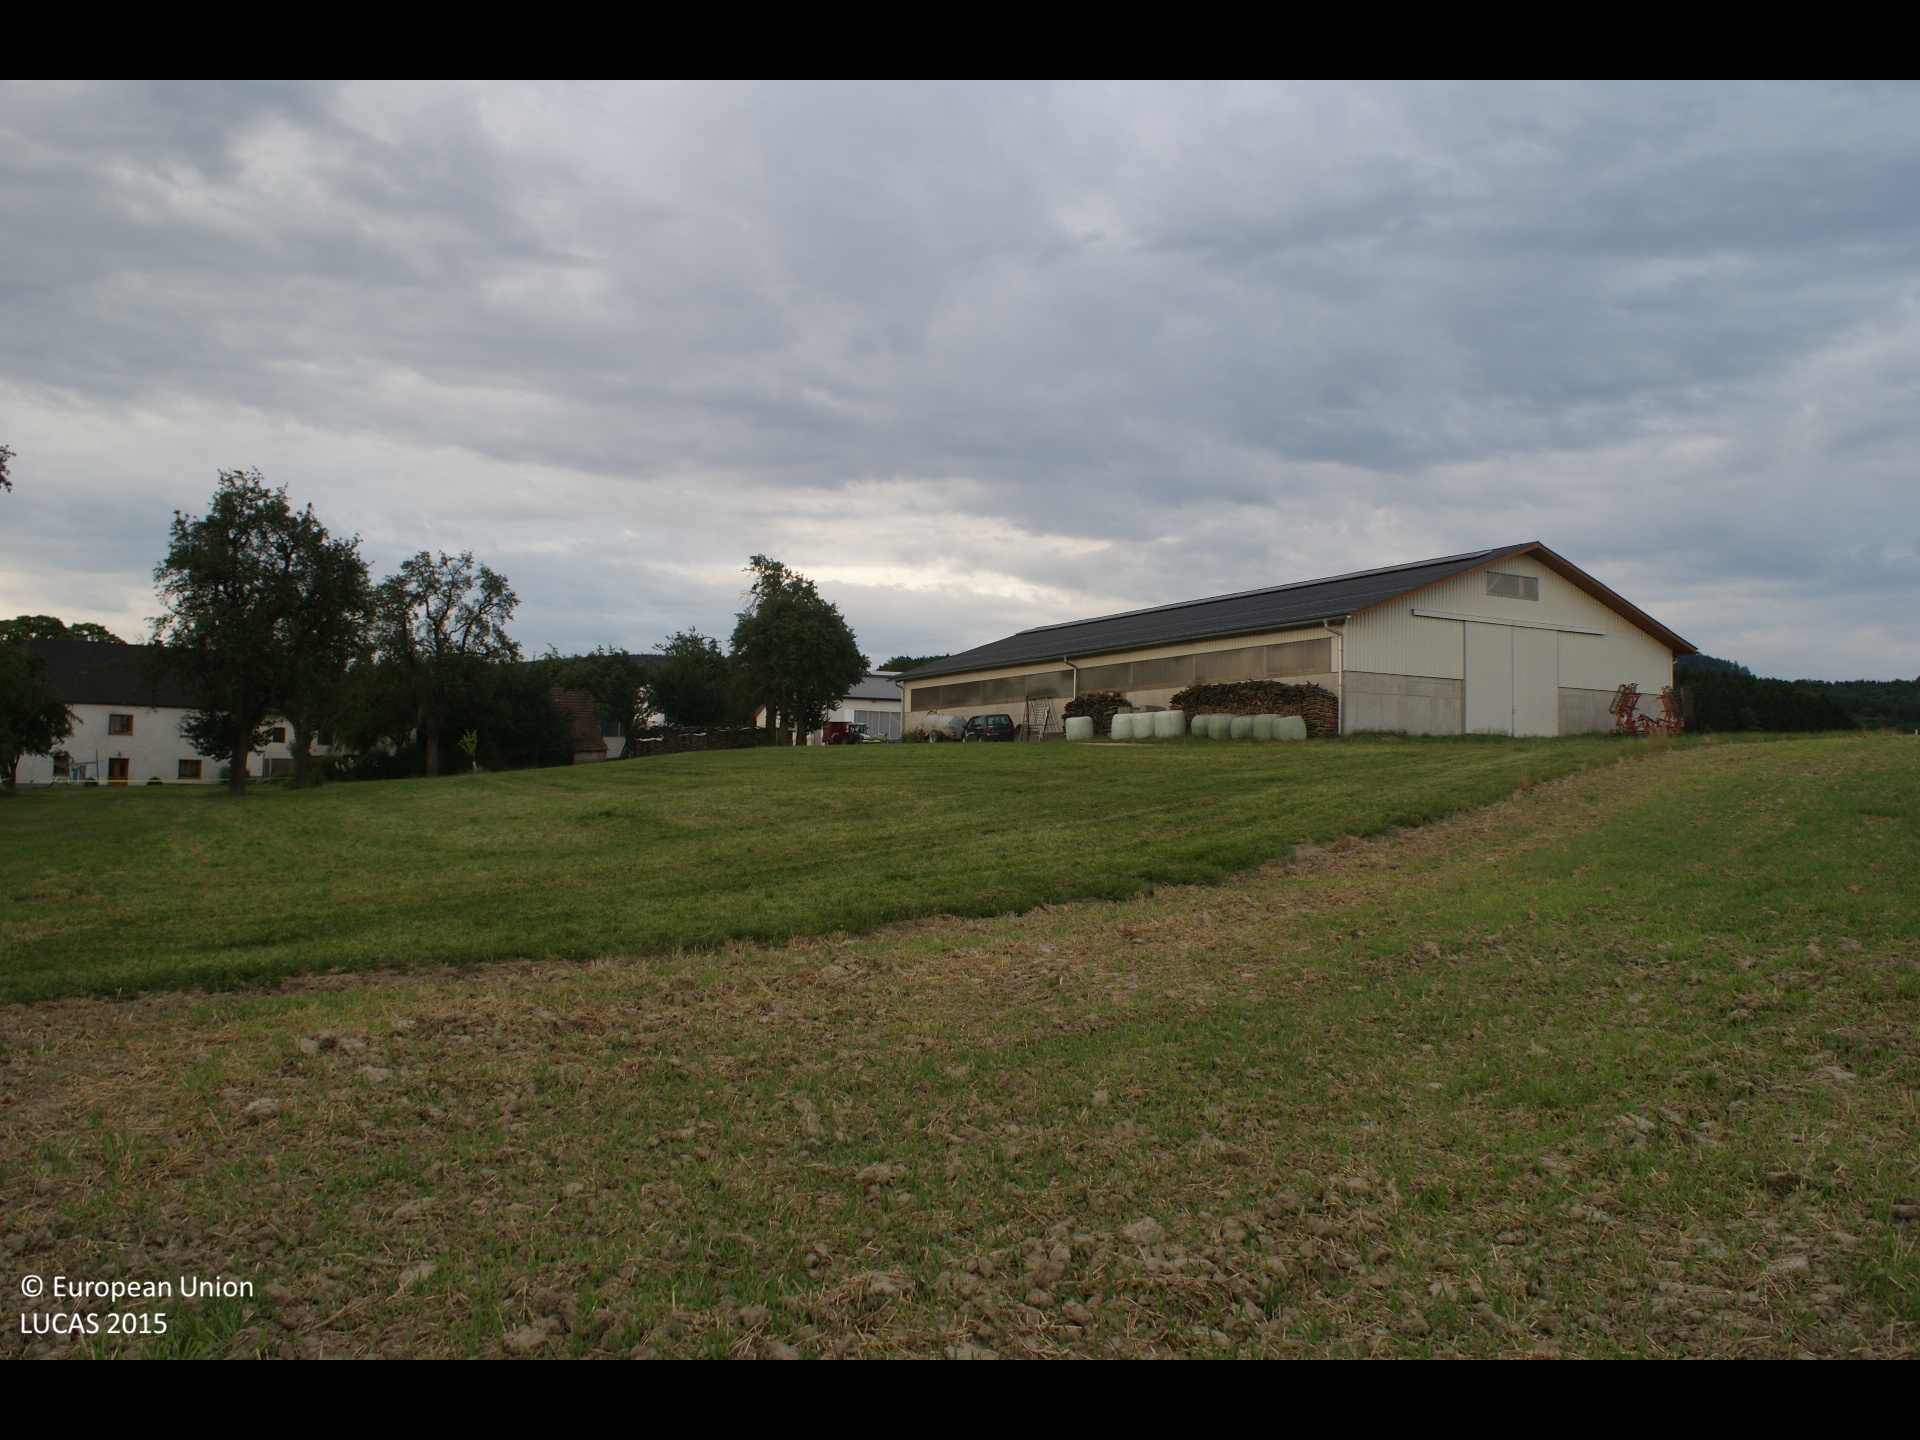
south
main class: Cropland
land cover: Temporary grasslands
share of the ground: 10 - 25 %
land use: Agriculture (excluding fallow land and kitchen gardens)
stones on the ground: < 10 %
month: July
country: AT
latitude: 48.0932
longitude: 15.3590
